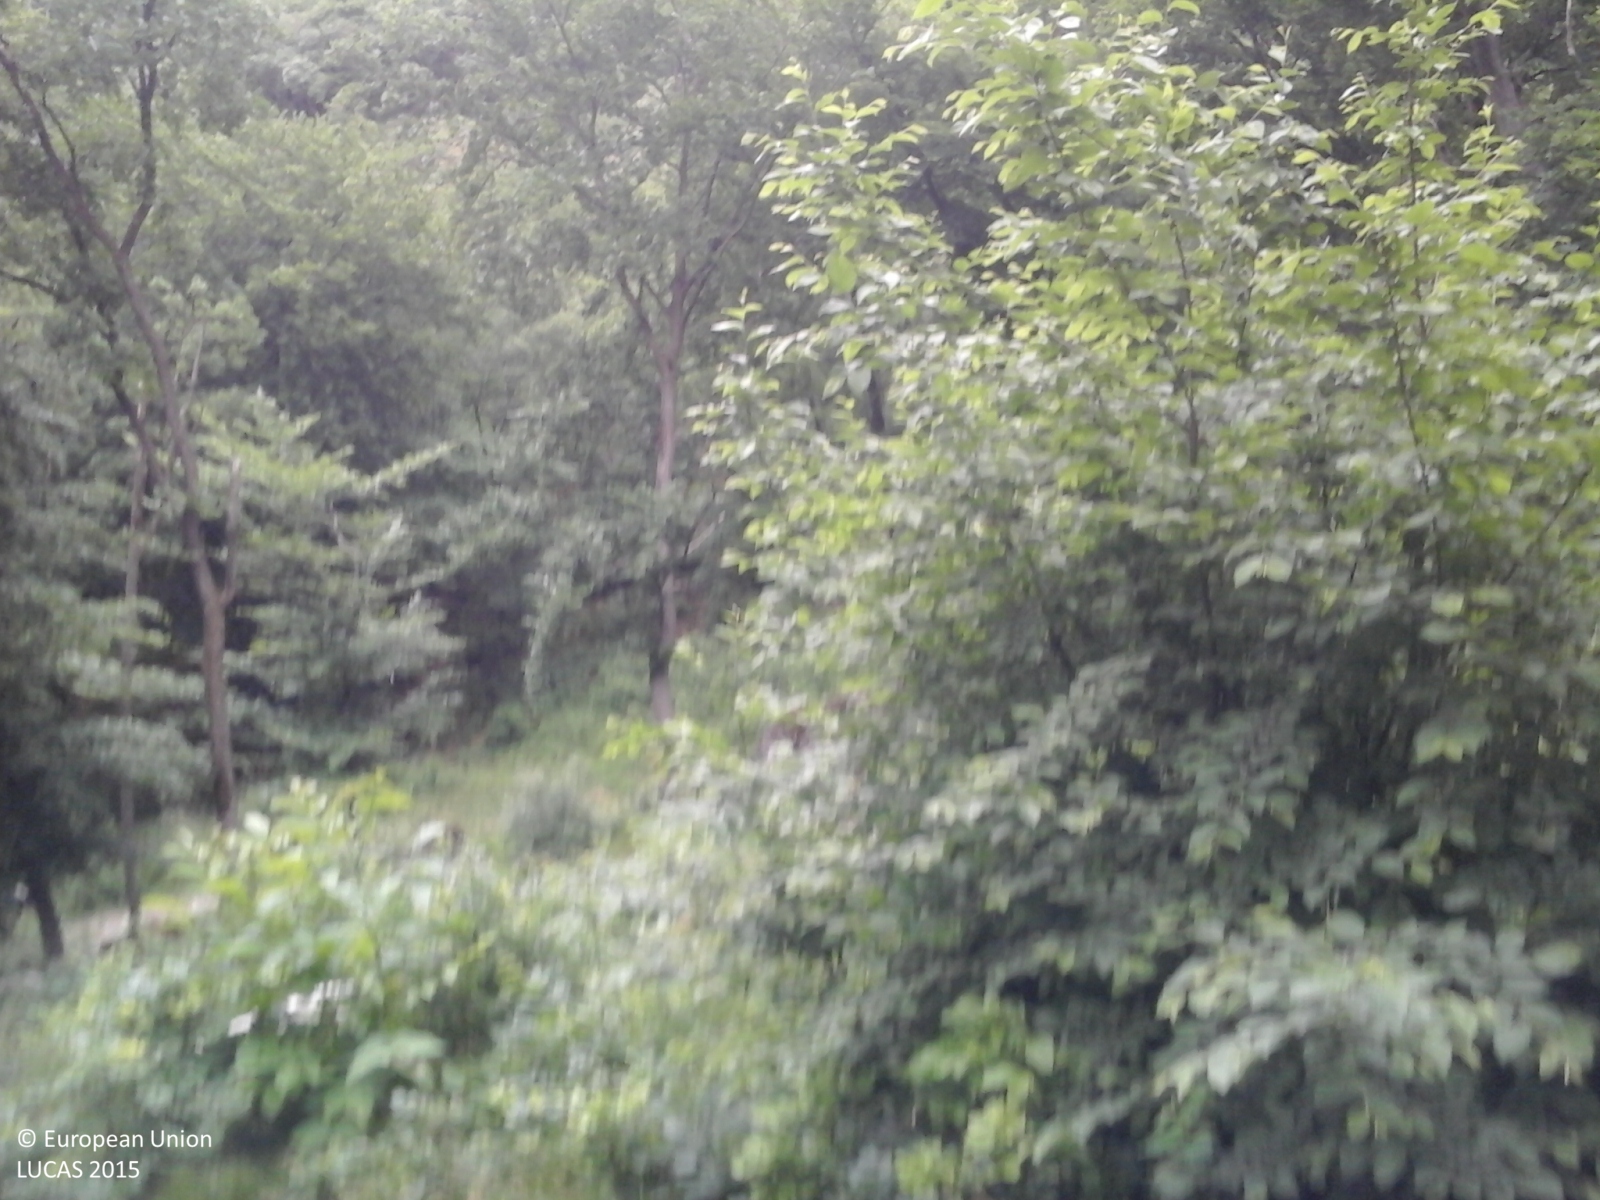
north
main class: Woodland
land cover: Broadleaved woodland
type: mountainous beech forest
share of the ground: > 75 %
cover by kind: broadleaved forest trees 90 %, herbaceous plants 10 %
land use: Forestry
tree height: > 5 m
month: May
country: IT
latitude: 45.6985
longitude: 10.9360
